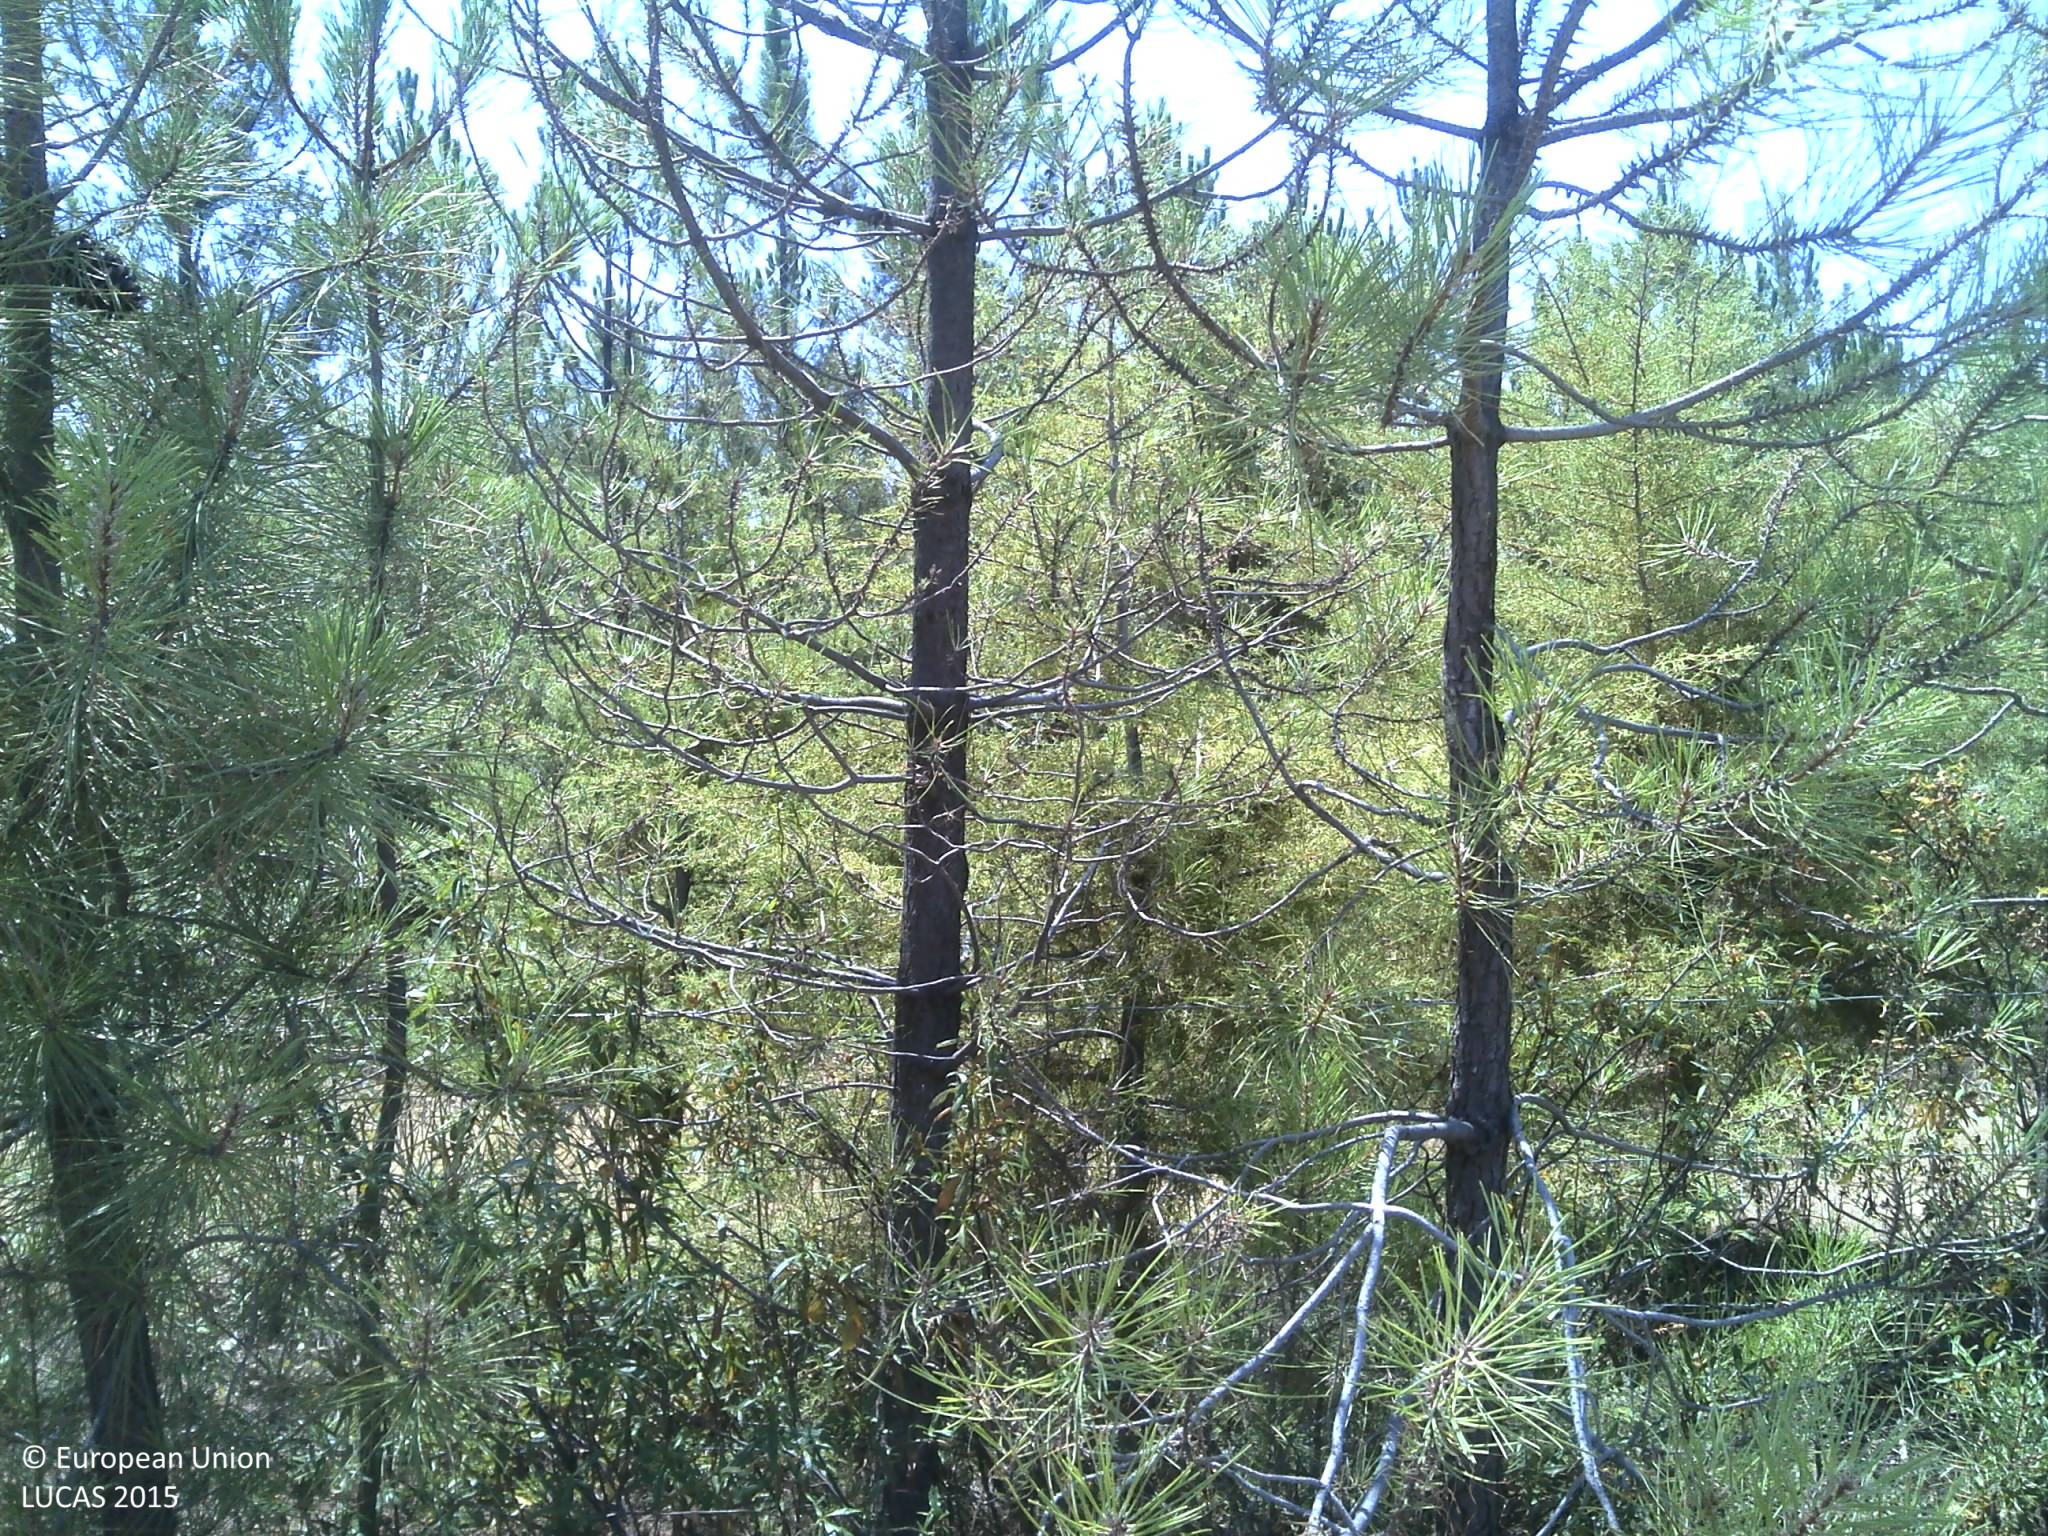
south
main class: Woodland
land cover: Pine dominated coniferous woodland
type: coniferous forest of the mediterranean region
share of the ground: > 75 %
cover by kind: coniferous forest trees 75 %, unconsolidated bare surface 25 %
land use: Forestry
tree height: > 5 m
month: June
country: PT
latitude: 40.0781
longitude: -7.0137
